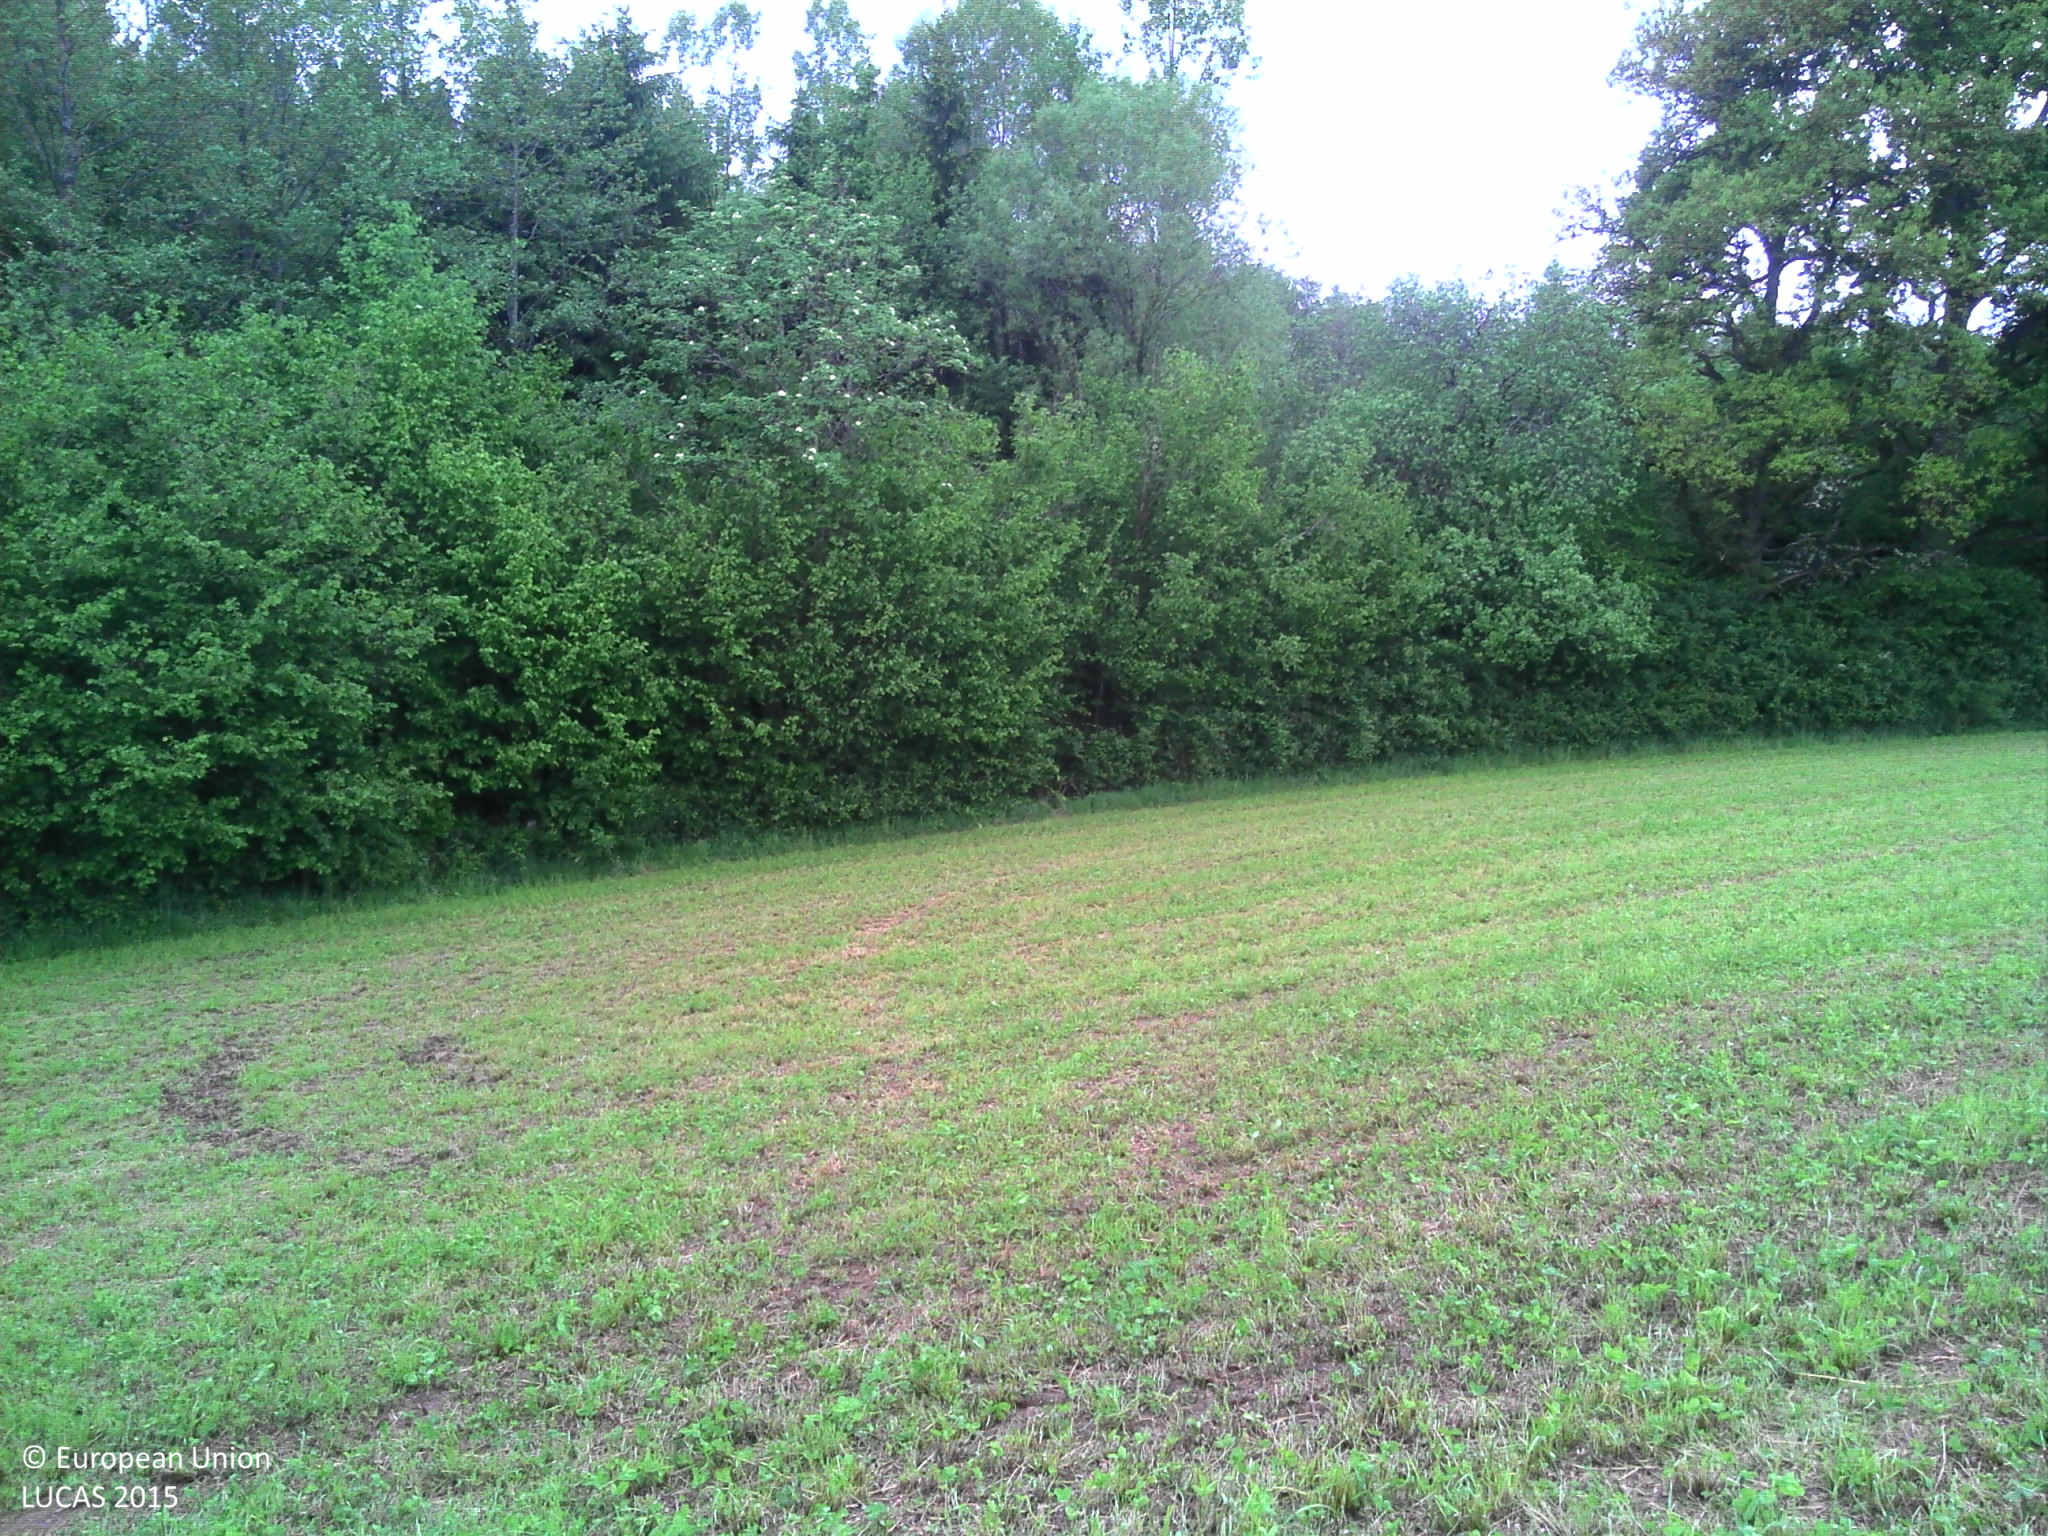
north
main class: Grassland
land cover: Grassland without tree/shrub cover
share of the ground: > 75 %
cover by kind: herbaceous plants 100 %
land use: Agriculture (excluding fallow land and kitchen gardens)
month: June
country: BE
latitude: 50.3219
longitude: 5.7710
